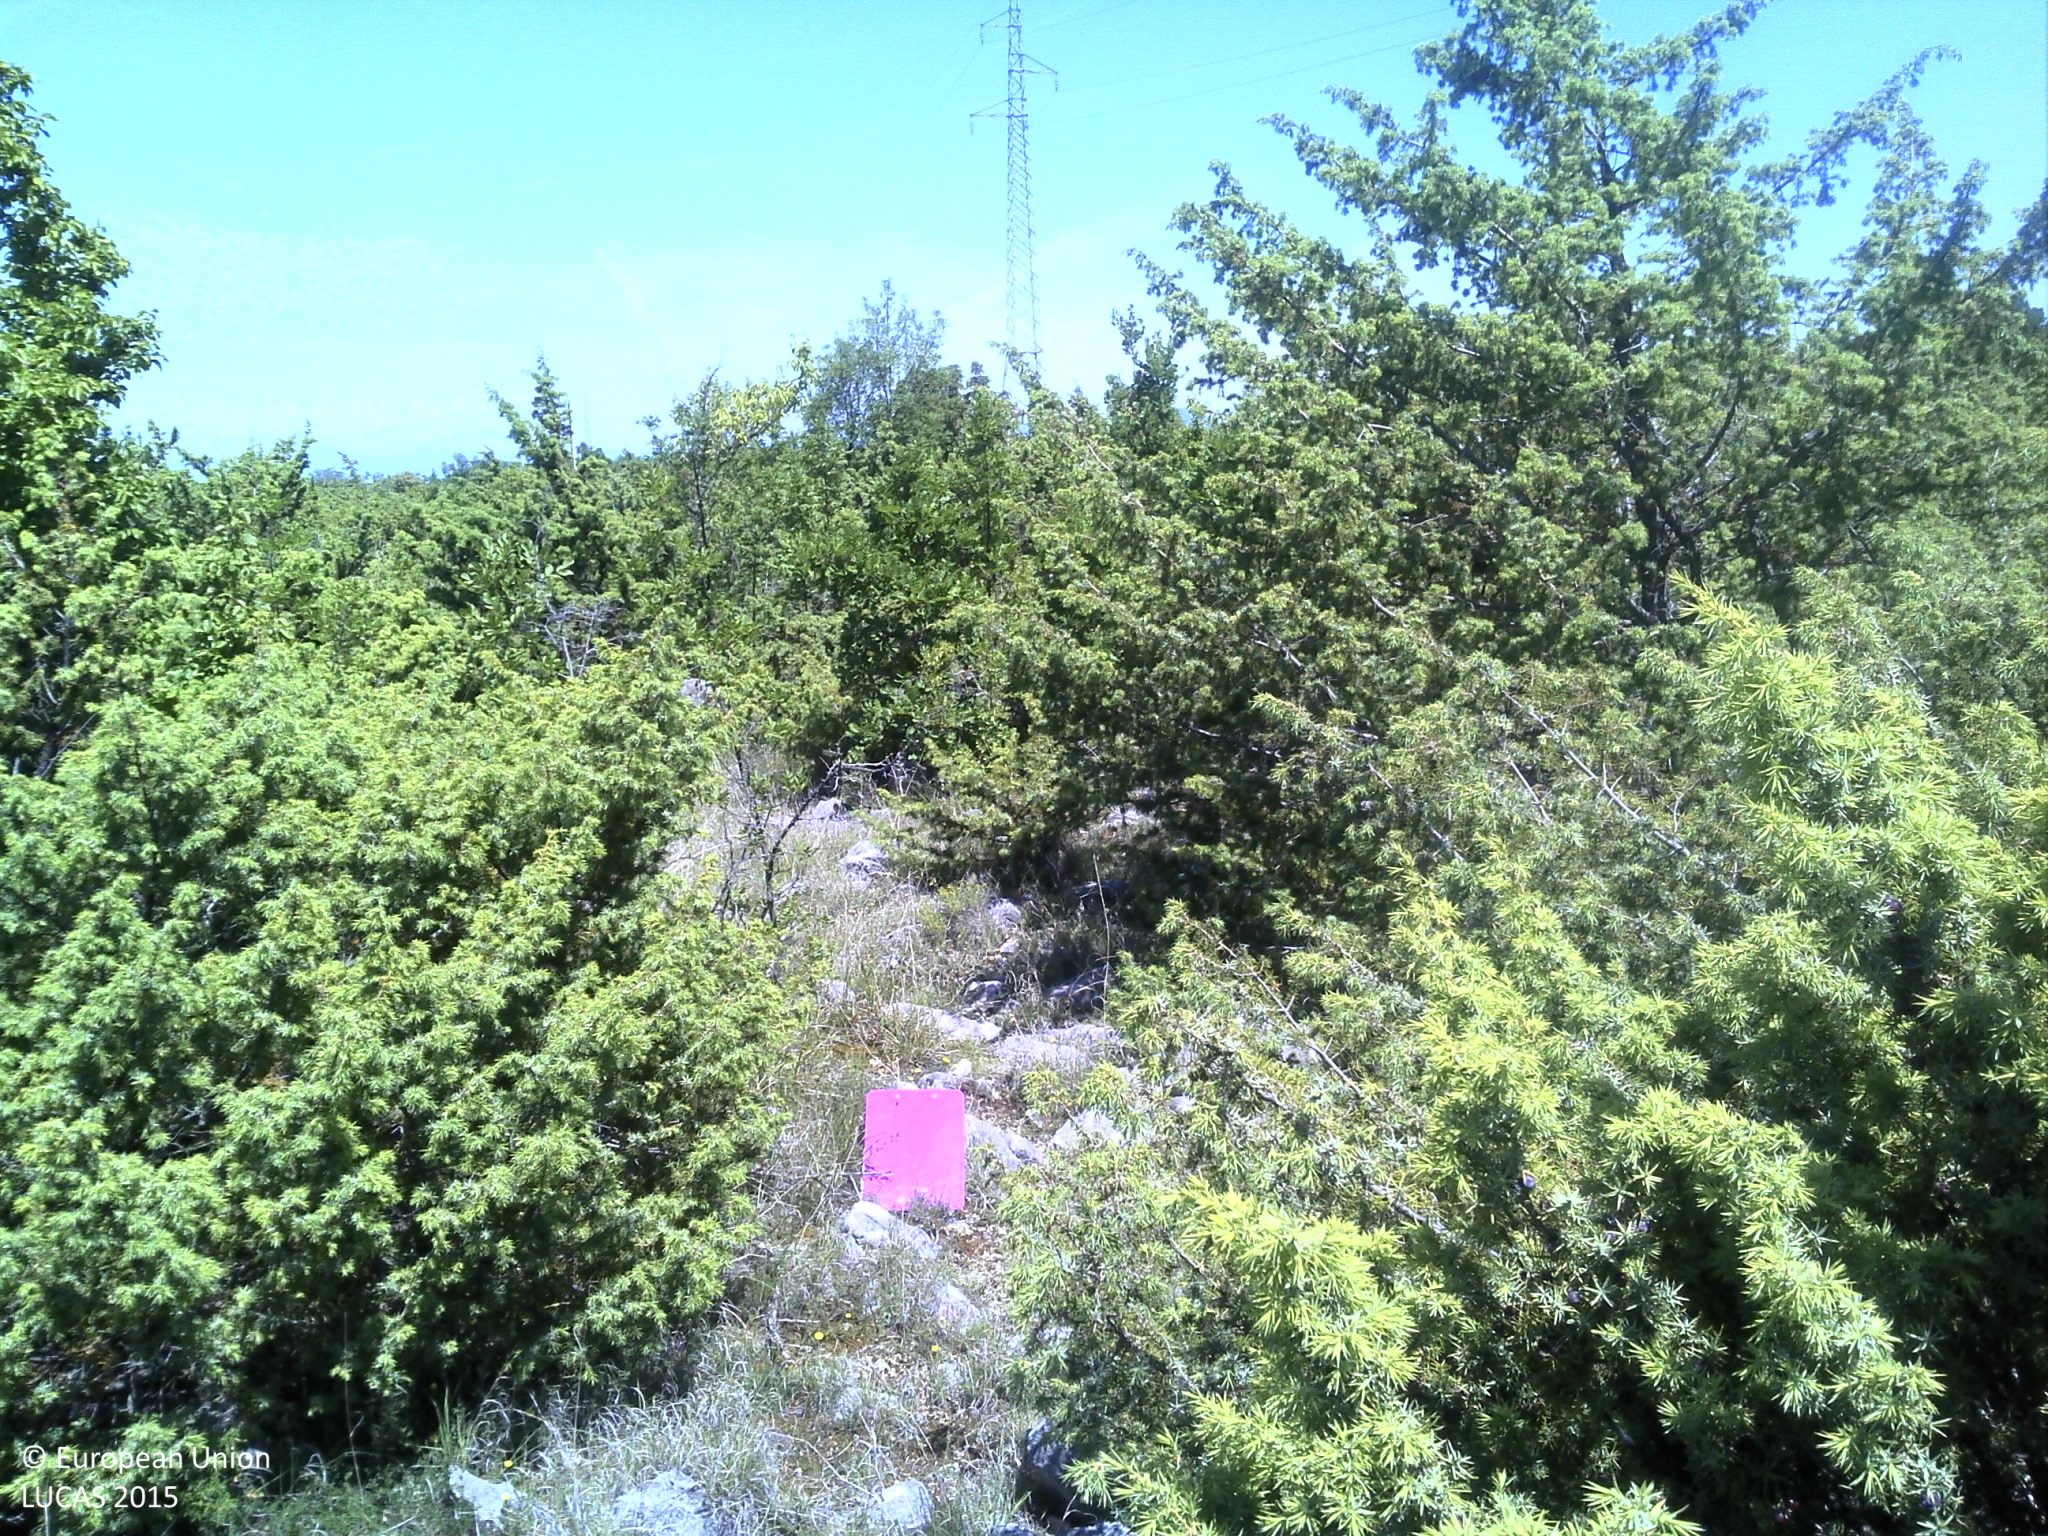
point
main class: Shrubland
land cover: Shrubland with sparse tree cover
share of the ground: 50 - 75 %
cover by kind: shrubs 50 %, herbaceous plants 35 %, unconsolidated bare surface 10 %, coniferous forest trees 5 %
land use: Semi-natural and natural areas not in use
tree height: < 5 m
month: May
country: HR
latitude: 43.9355
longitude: 16.1086
